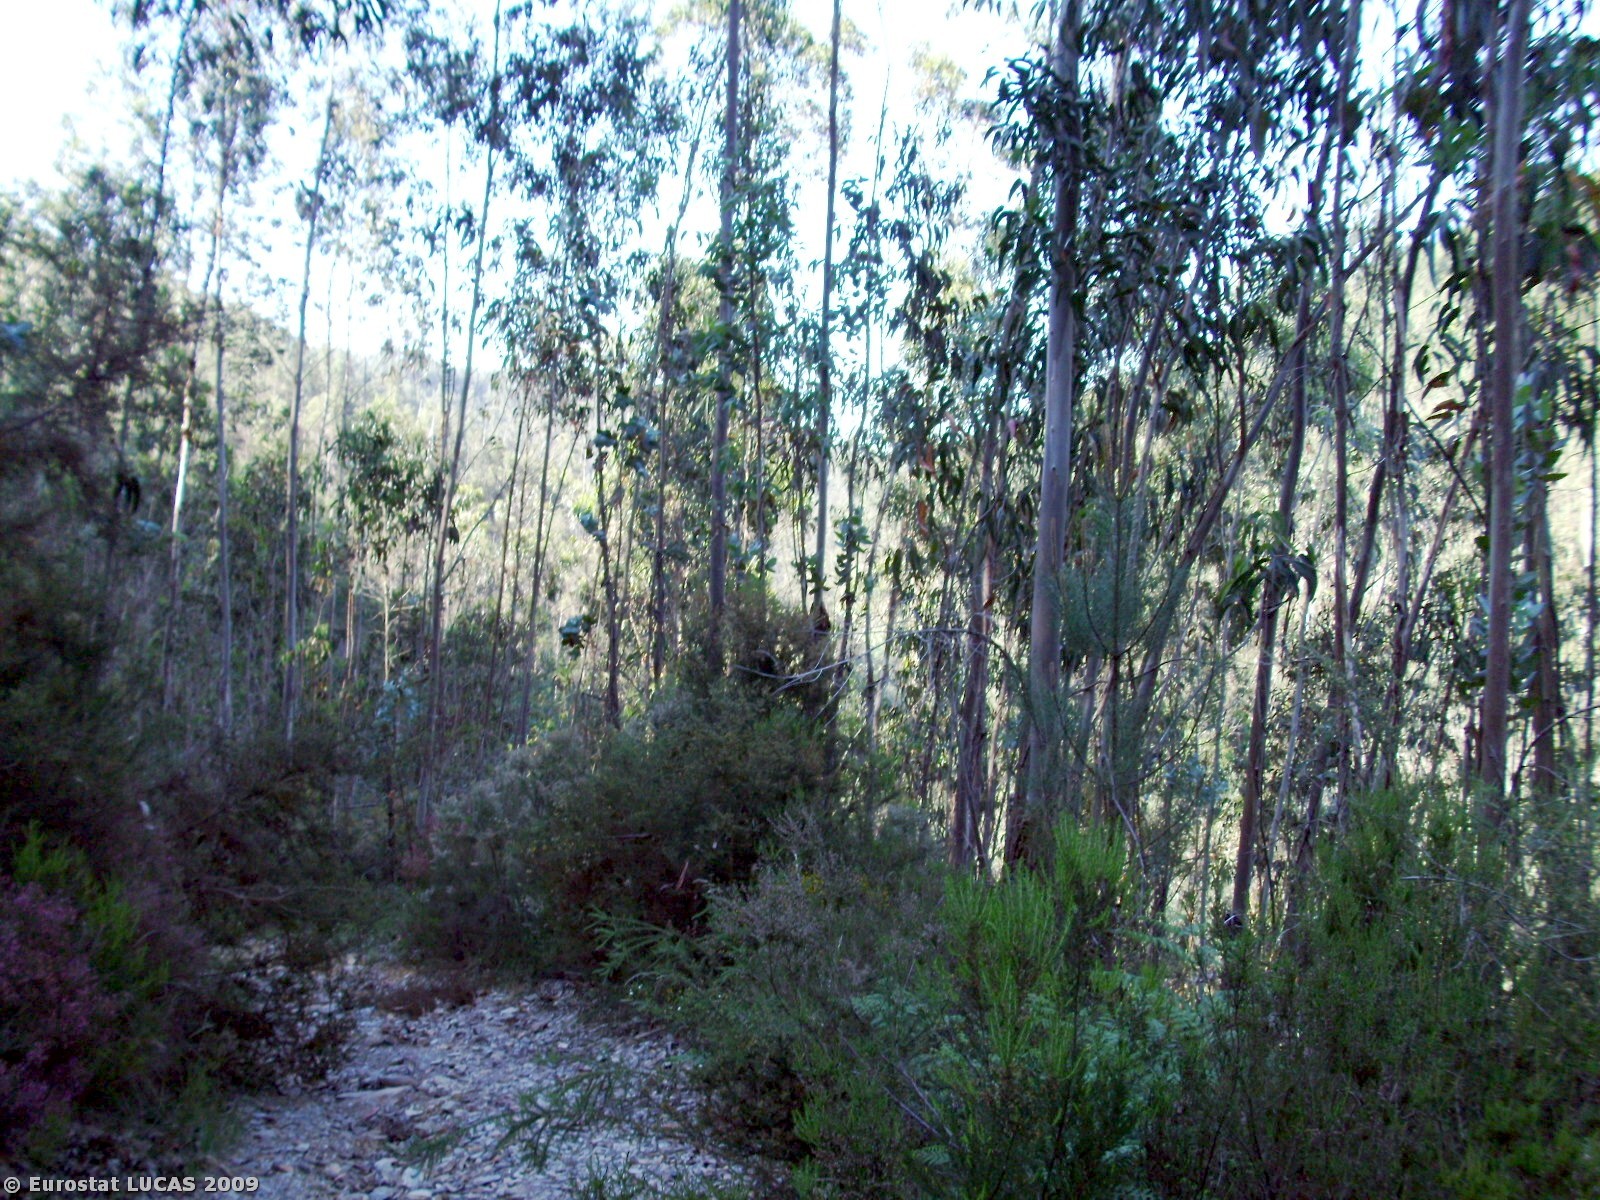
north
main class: Woodland
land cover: Broadleaved woodland
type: plantations and self-sown exotic forest
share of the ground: > 75 %
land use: Forestry
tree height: > 5 m
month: May
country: PT
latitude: 40.5834
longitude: -8.3895
